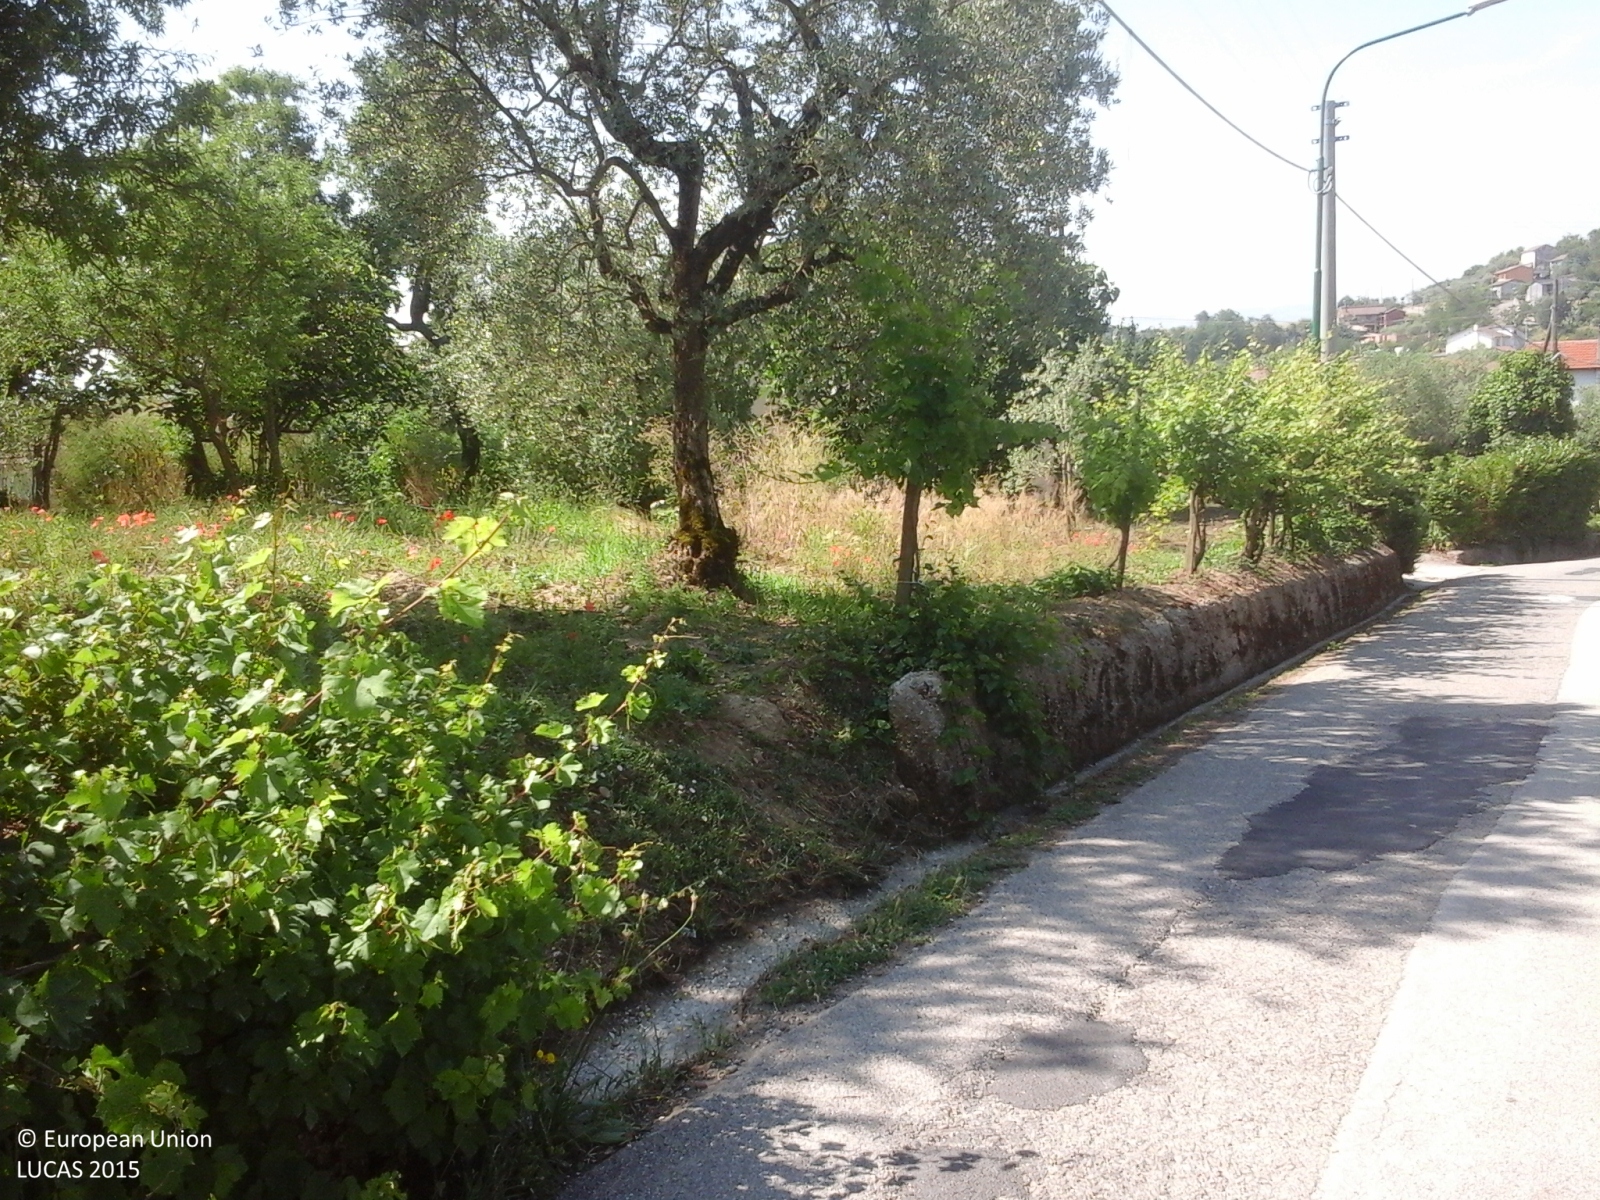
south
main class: Cropland
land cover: Olive groves
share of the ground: 50 - 75 %
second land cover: Spontaneously vegetated surfaces
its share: 10 - 25 %
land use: Agriculture (excluding fallow land and kitchen gardens)
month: June
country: IT
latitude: 41.1139
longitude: 15.0901
